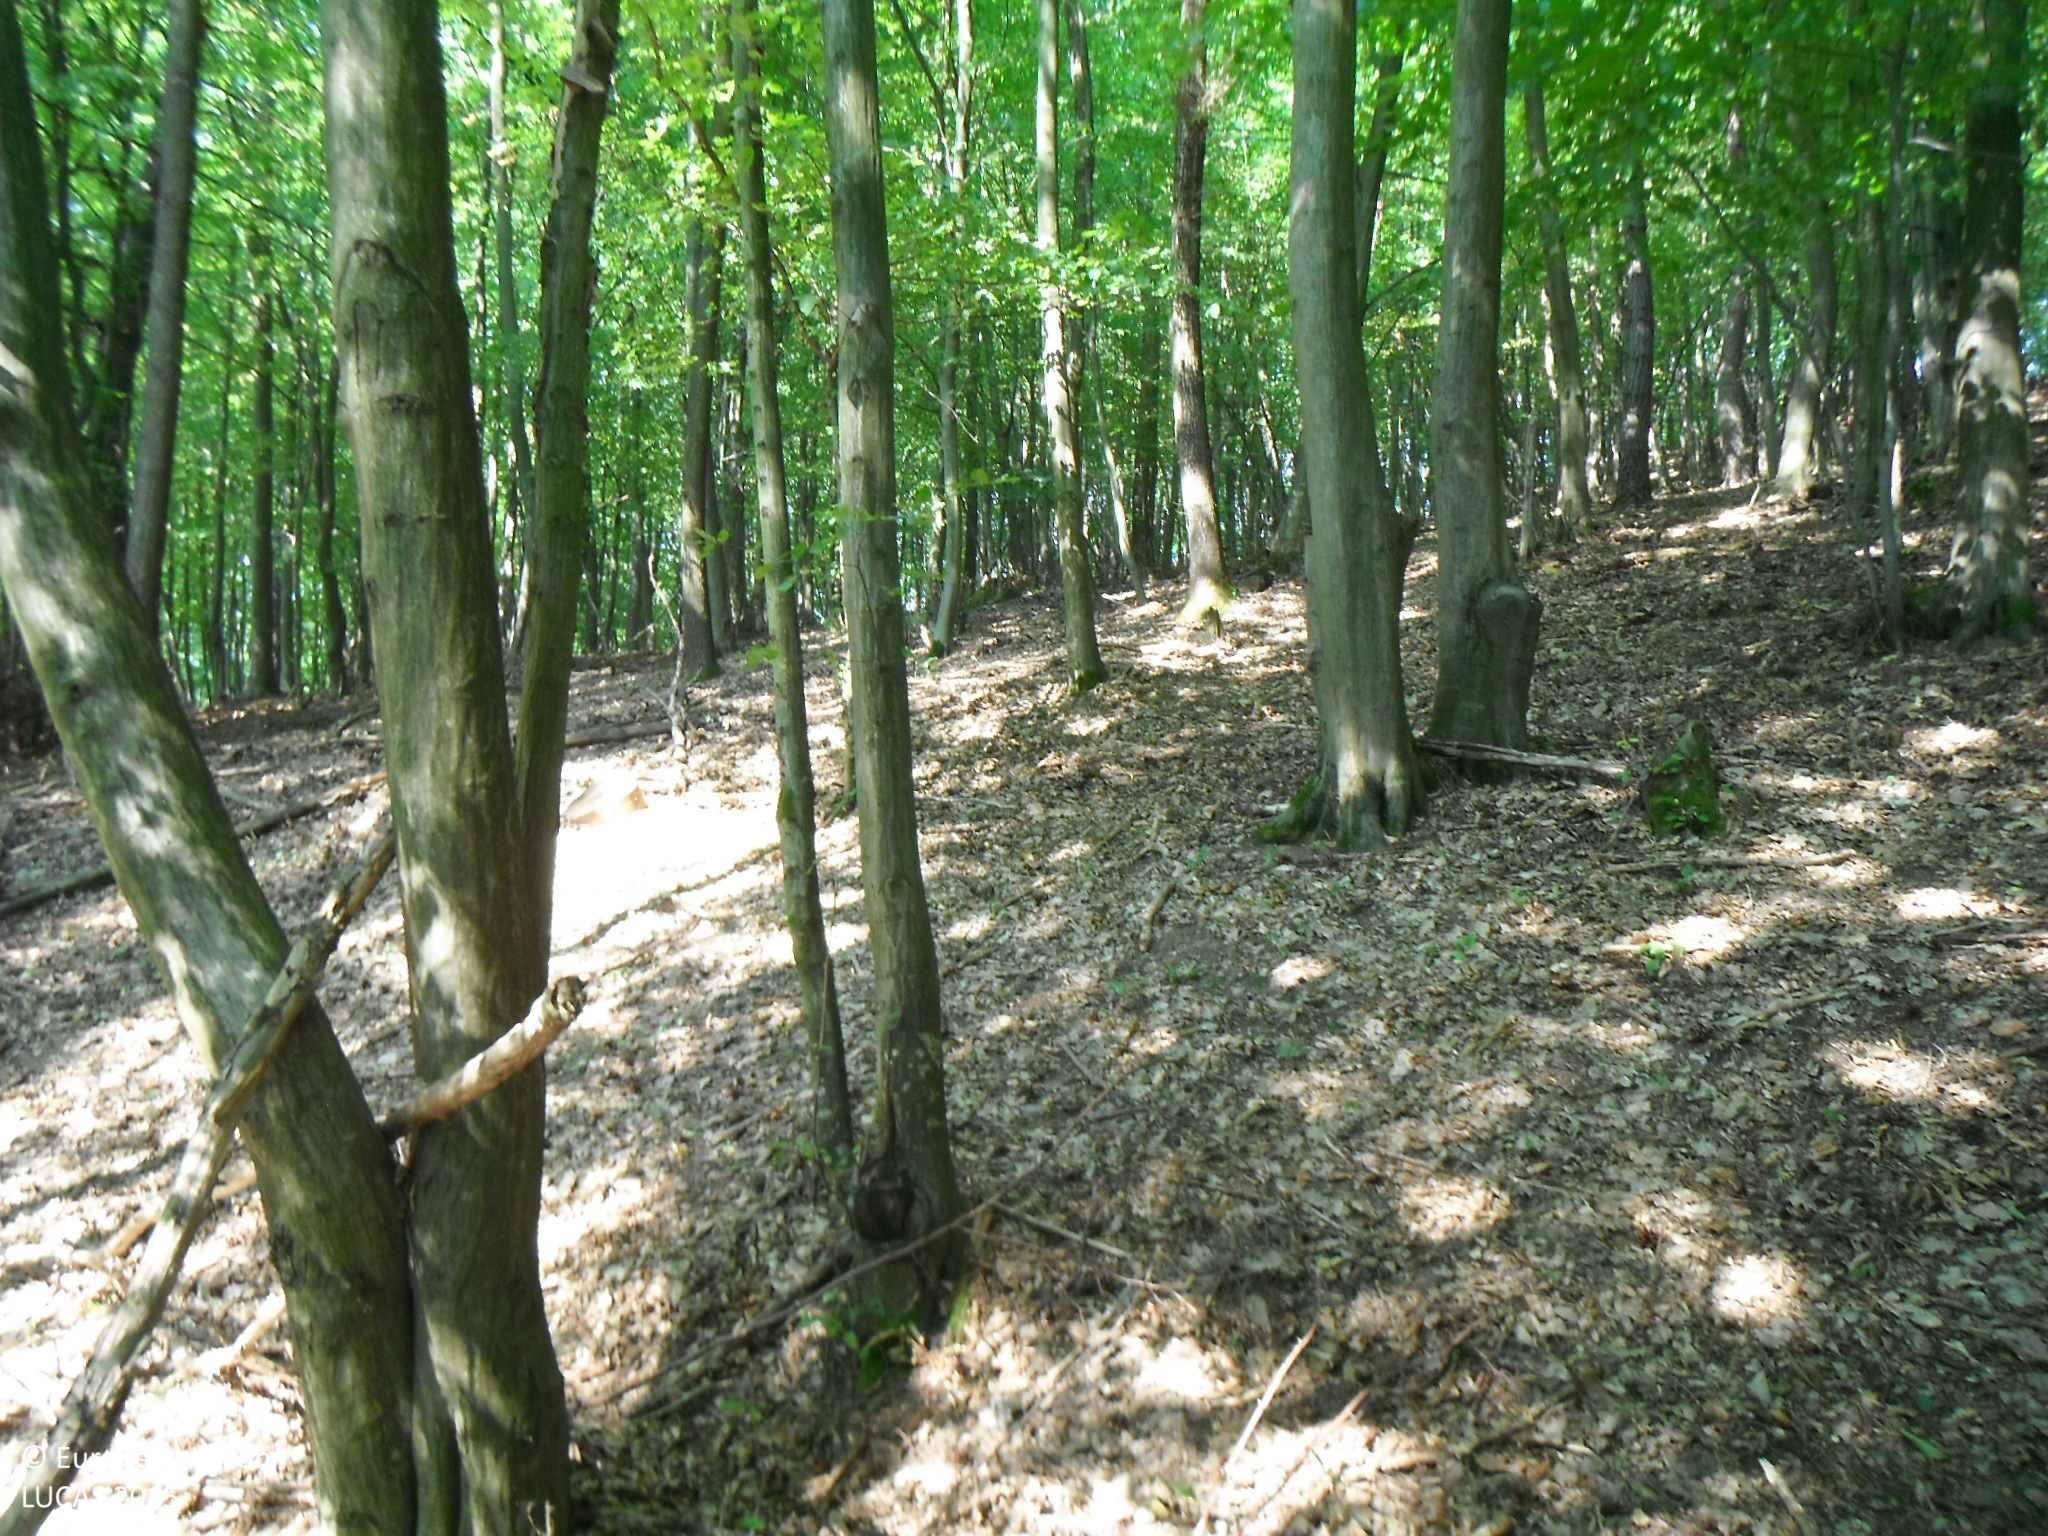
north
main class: Woodland
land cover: Pine dominated mixed woodland
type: mesophytic deciduous forest
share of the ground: > 75 %
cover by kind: broadleaved forest trees 60 %, coniferous forest trees 40 %
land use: Forestry
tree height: > 5 m
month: August
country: SK
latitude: 49.1770
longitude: 18.2883
